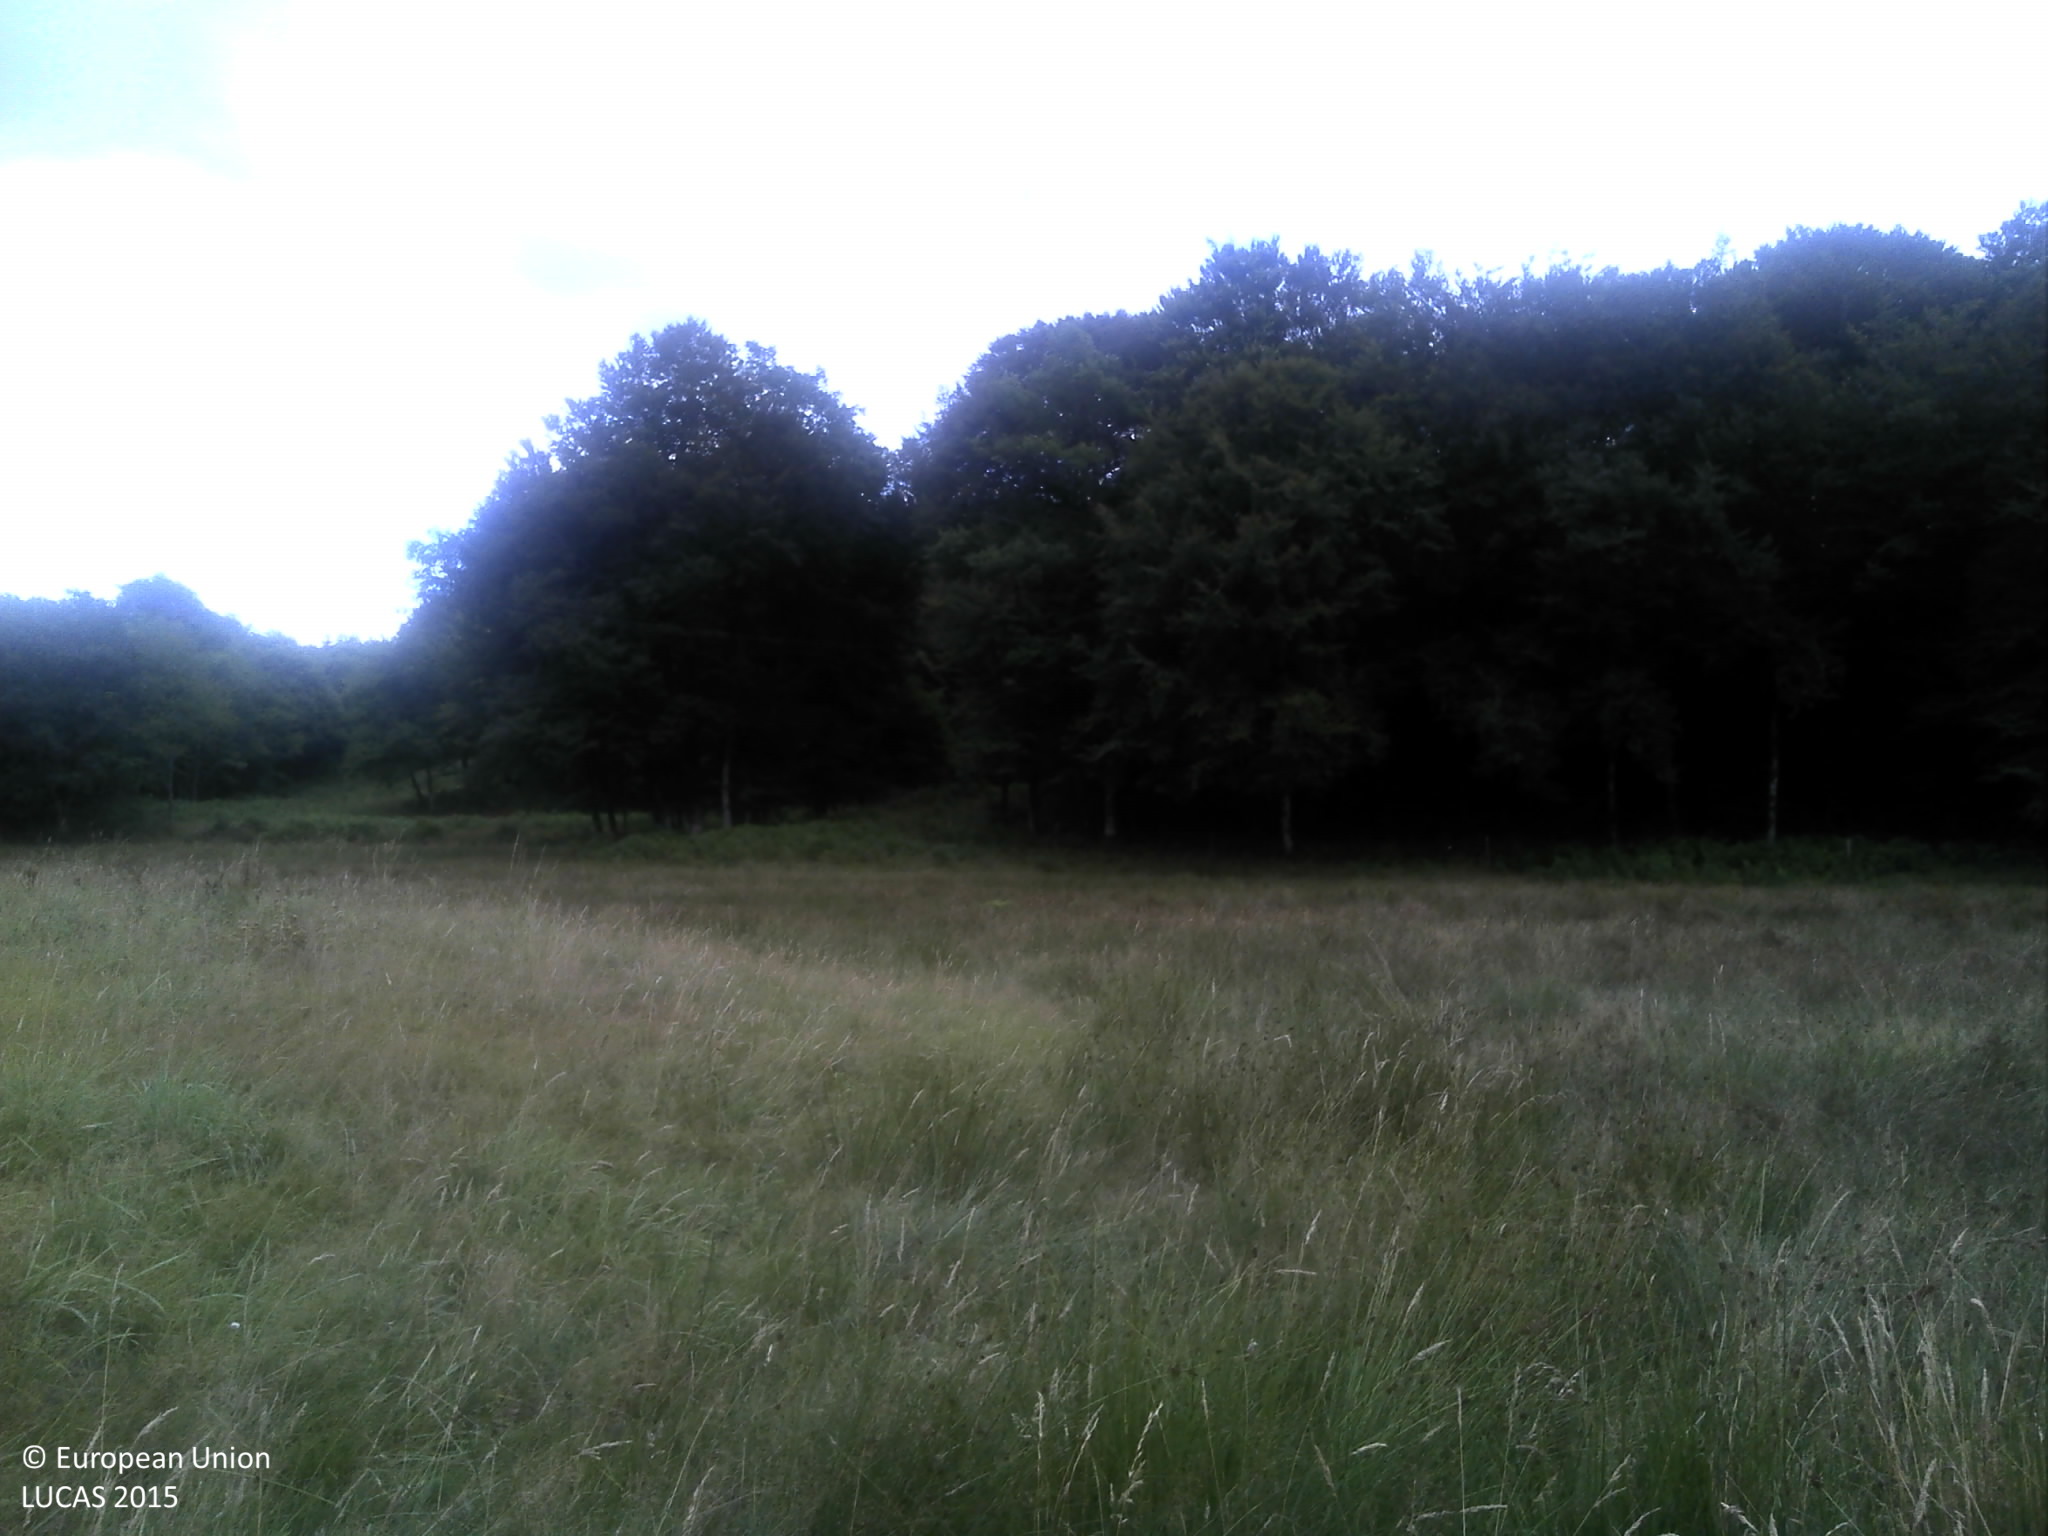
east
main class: Grassland
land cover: Grassland without tree/shrub cover
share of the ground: > 75 %
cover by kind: herbaceous plants 100 %
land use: Agriculture (excluding fallow land and kitchen gardens)
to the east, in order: Grassland without tree/shrub cover; Fences; Broadleaved woodland; Fences; Grassland without tree/shrub cover; Fences; Broadleaved woodland
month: July
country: FR
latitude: 45.2118
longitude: 1.9117
